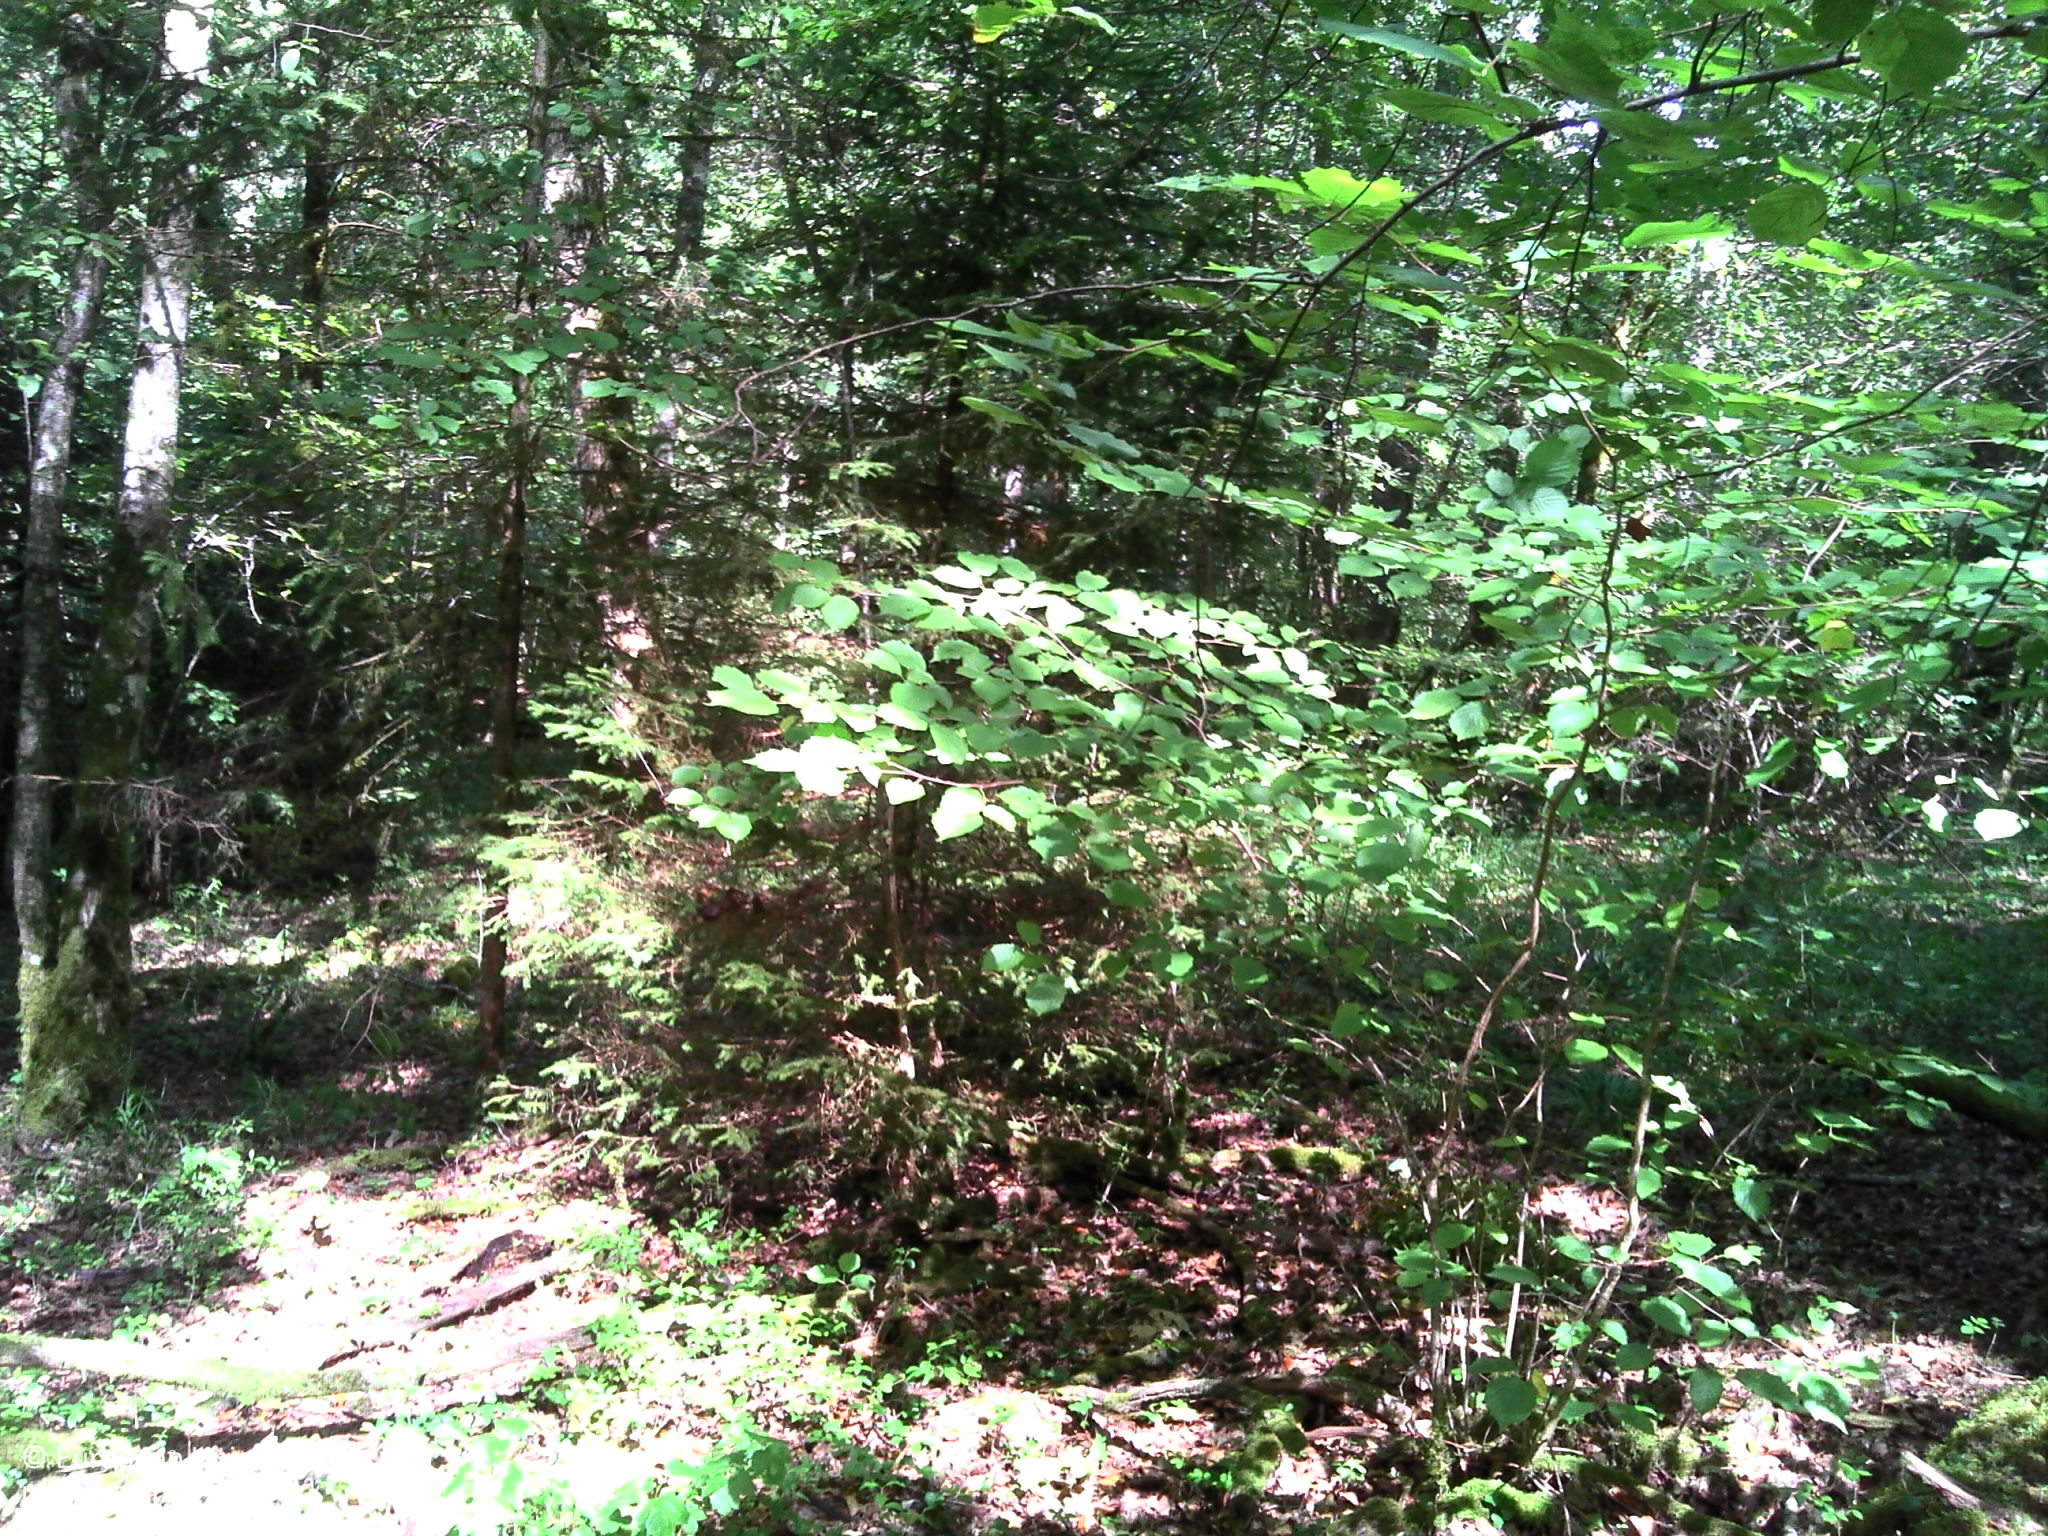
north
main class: Woodland
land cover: Broadleaved woodland
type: mesophytic deciduous forest
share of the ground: > 75 %
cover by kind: broadleaved forest trees 70 %, coniferous forest trees 20 %, herbaceous plants 5 %, lichens and mosses 5 %
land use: Forestry
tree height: > 5 m
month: August
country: FR
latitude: 47.8151
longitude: 4.8575
